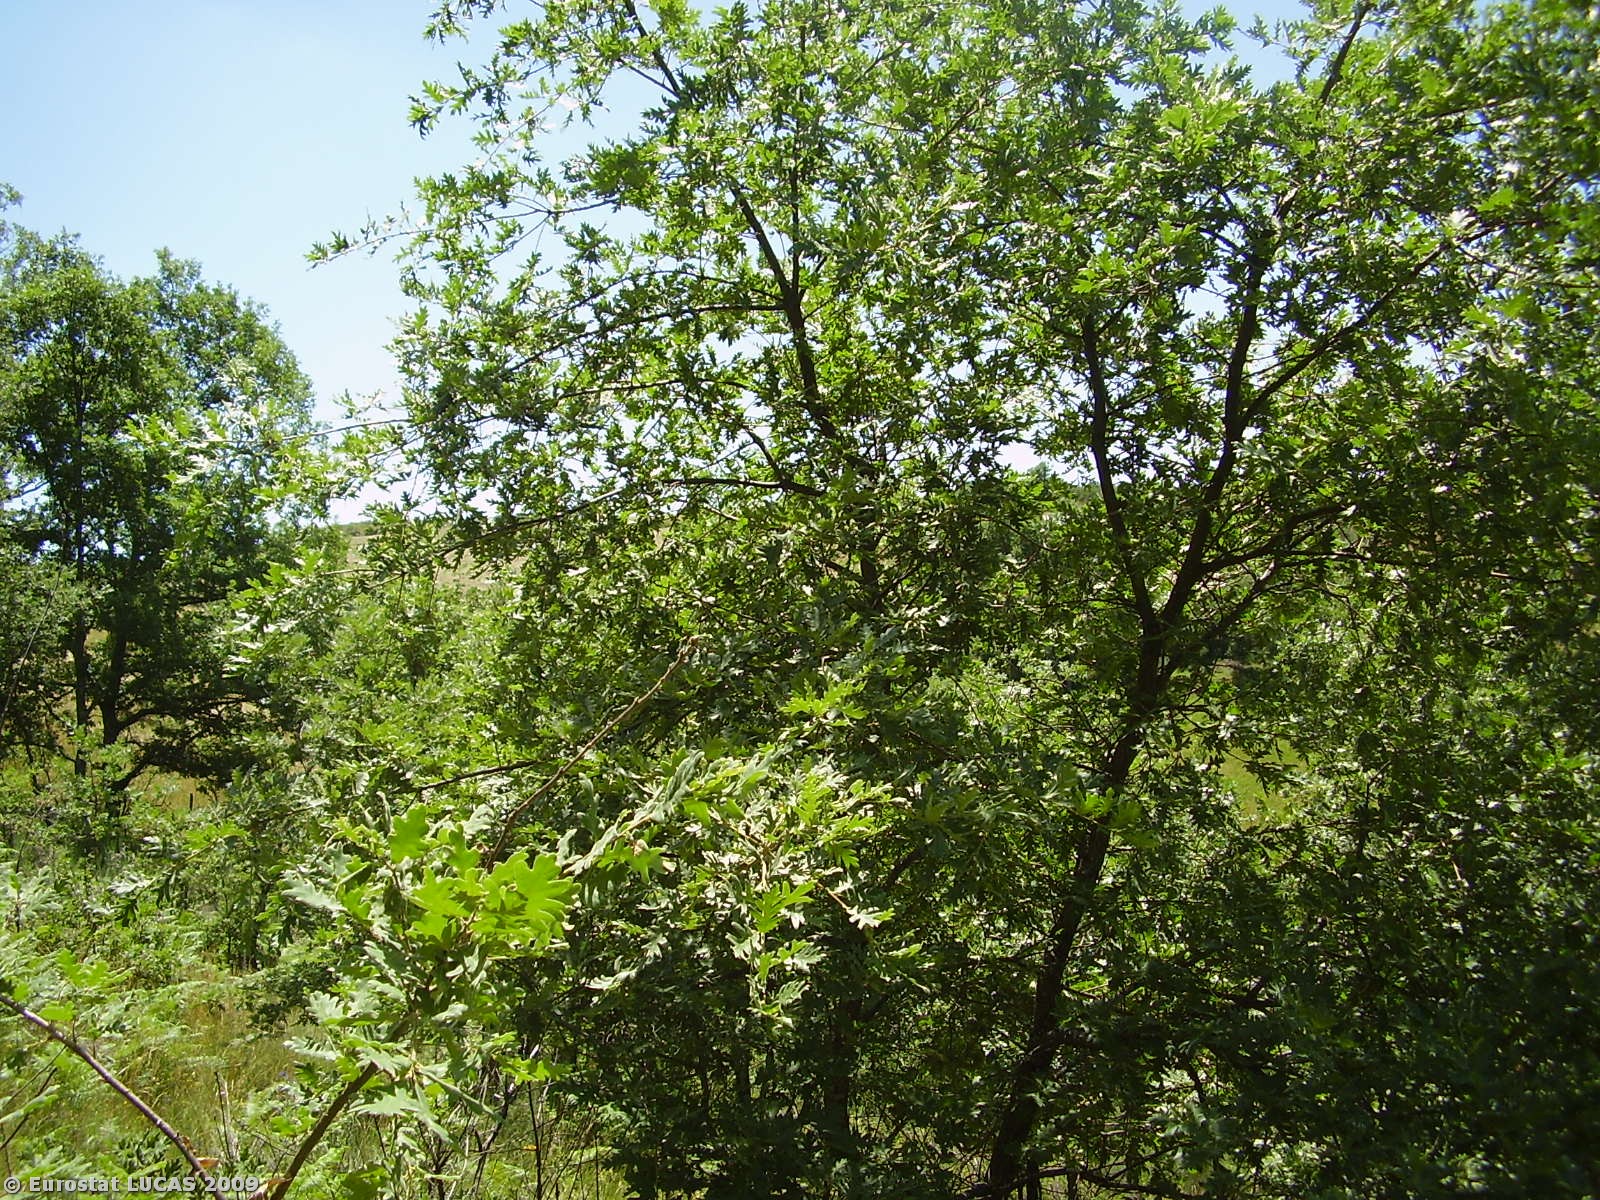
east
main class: Shrubland
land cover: Shrubland with sparse tree cover
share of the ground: 10 - 25 %
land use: Nature reserves
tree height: > 5 m
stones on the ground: 25 - 50 %
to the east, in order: Shrubland with sparse tree cover; Fences; Spontaneously vegetated surfaces; Broadleaved woodland; Durum wheat; Shruby margins; Other structural elements; Spontaneously vegetated surfaces; Shruby margins; Other structural elements; Paved roads, cycling and walking lanes; Grass margins; Other structural elements; Durum wheat; Nuts trees; Durum wheat
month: June
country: PT
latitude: 41.8622
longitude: -6.9234
